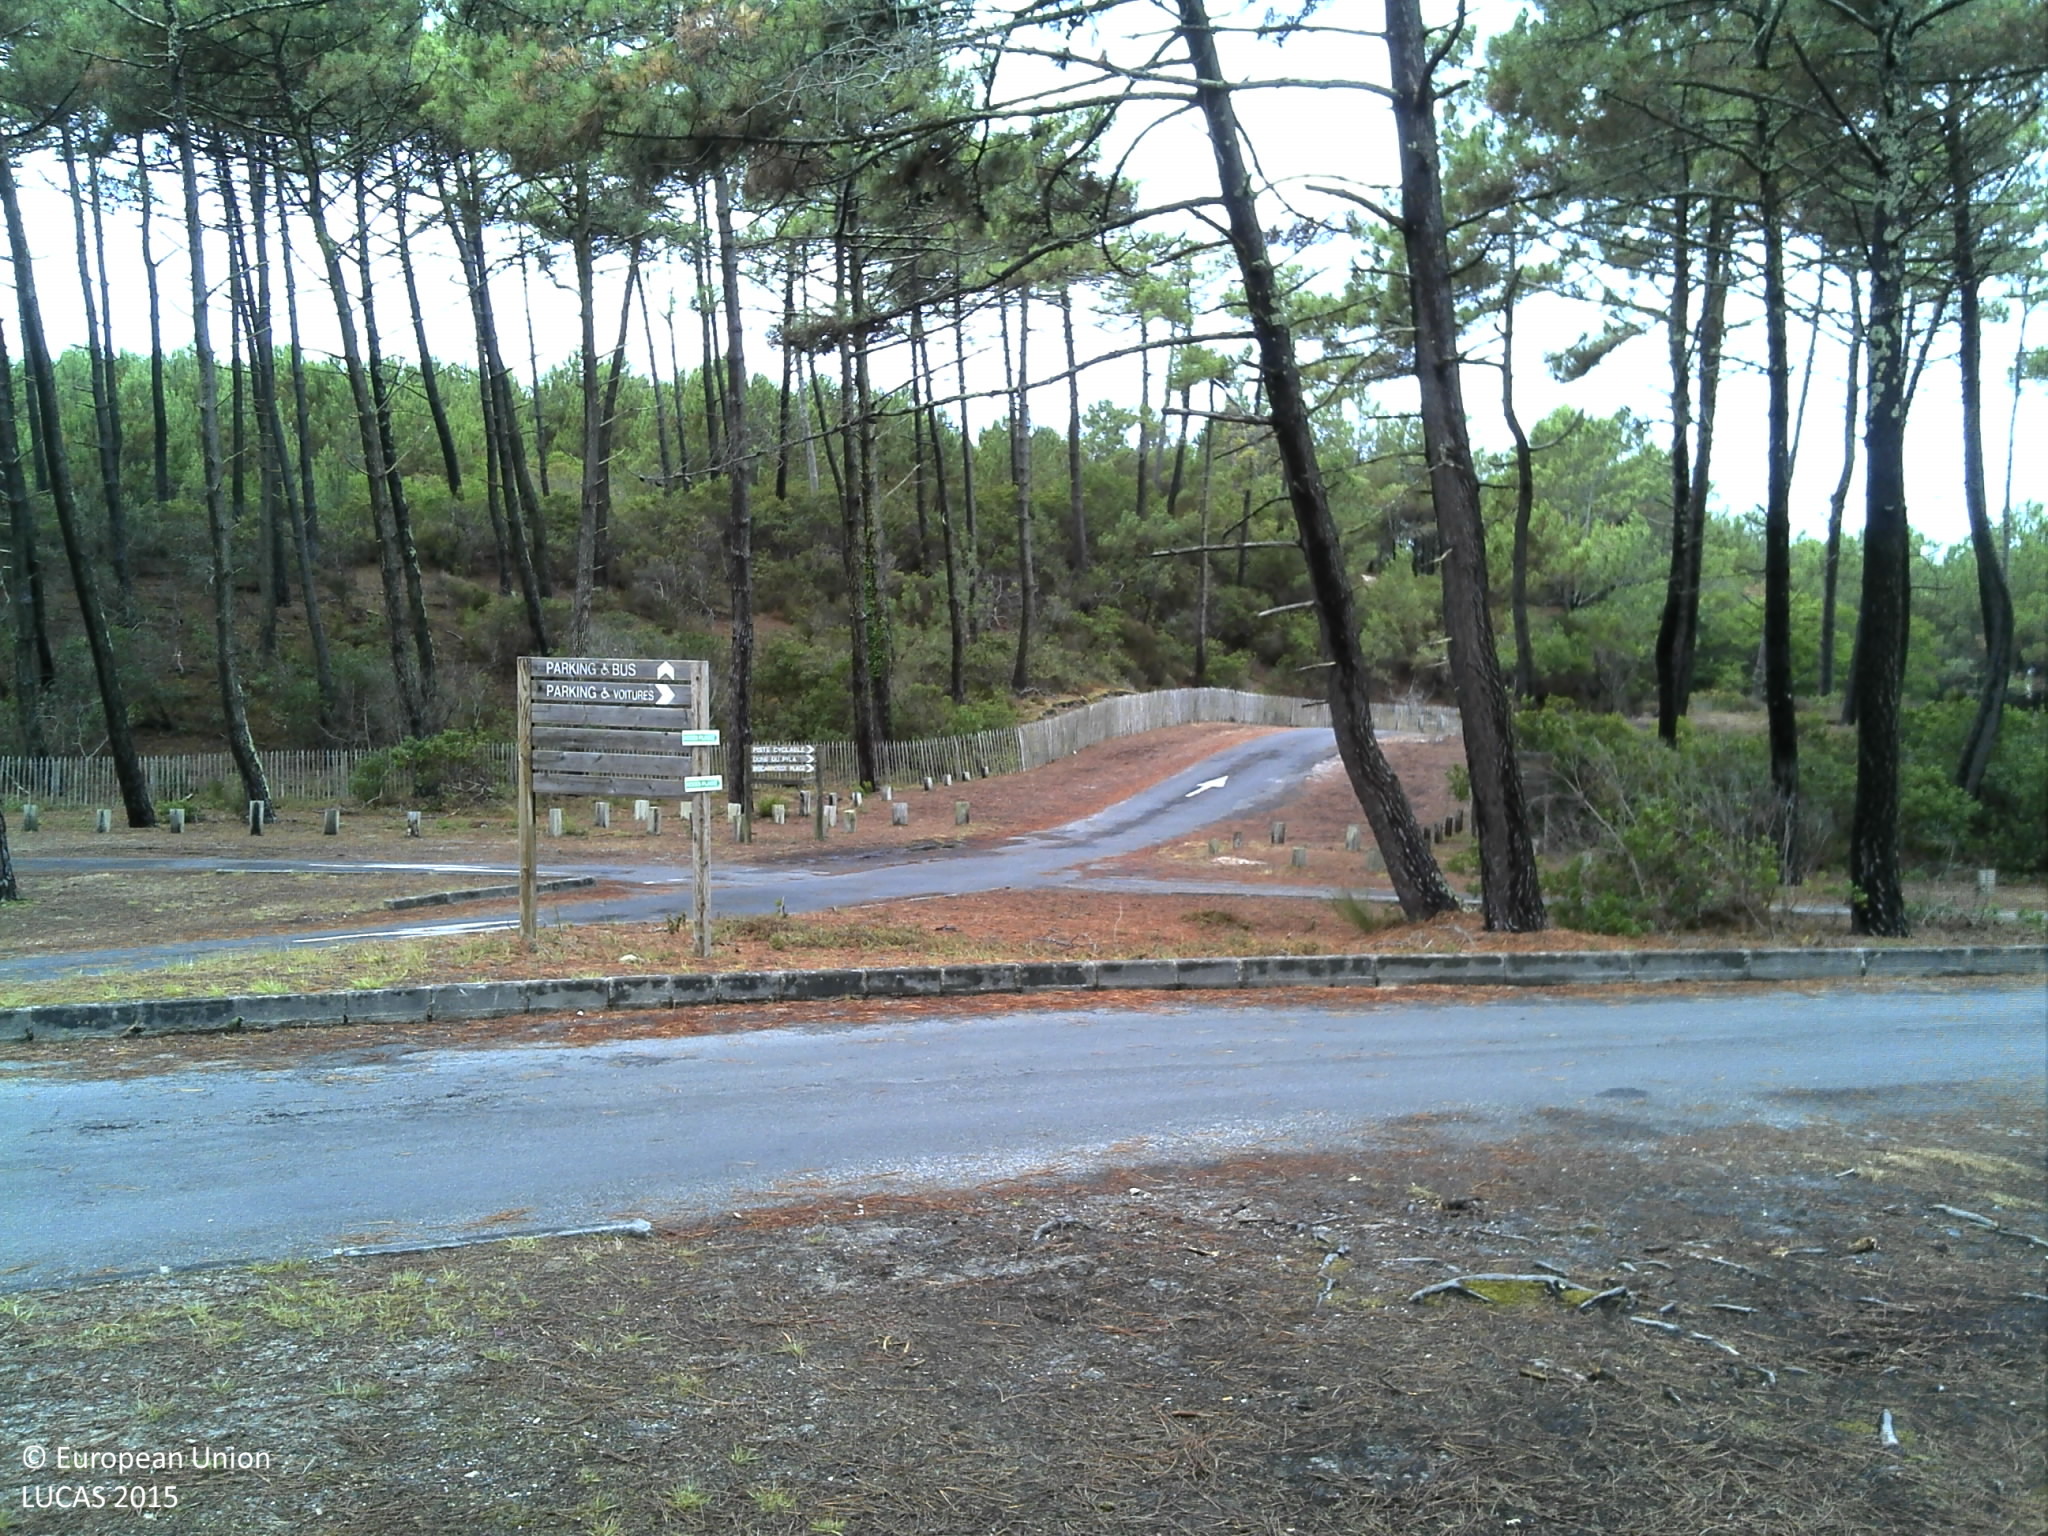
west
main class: Woodland
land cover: Pine dominated coniferous woodland
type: coniferous forest of the mediterranean region
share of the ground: > 75 %
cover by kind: coniferous forest trees 60 %, shrubs 30 %, herbaceous plants 5 %, lichens and mosses 5 %
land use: Forestry
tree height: > 5 m
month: July
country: FR
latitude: 44.5566
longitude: -1.2403
